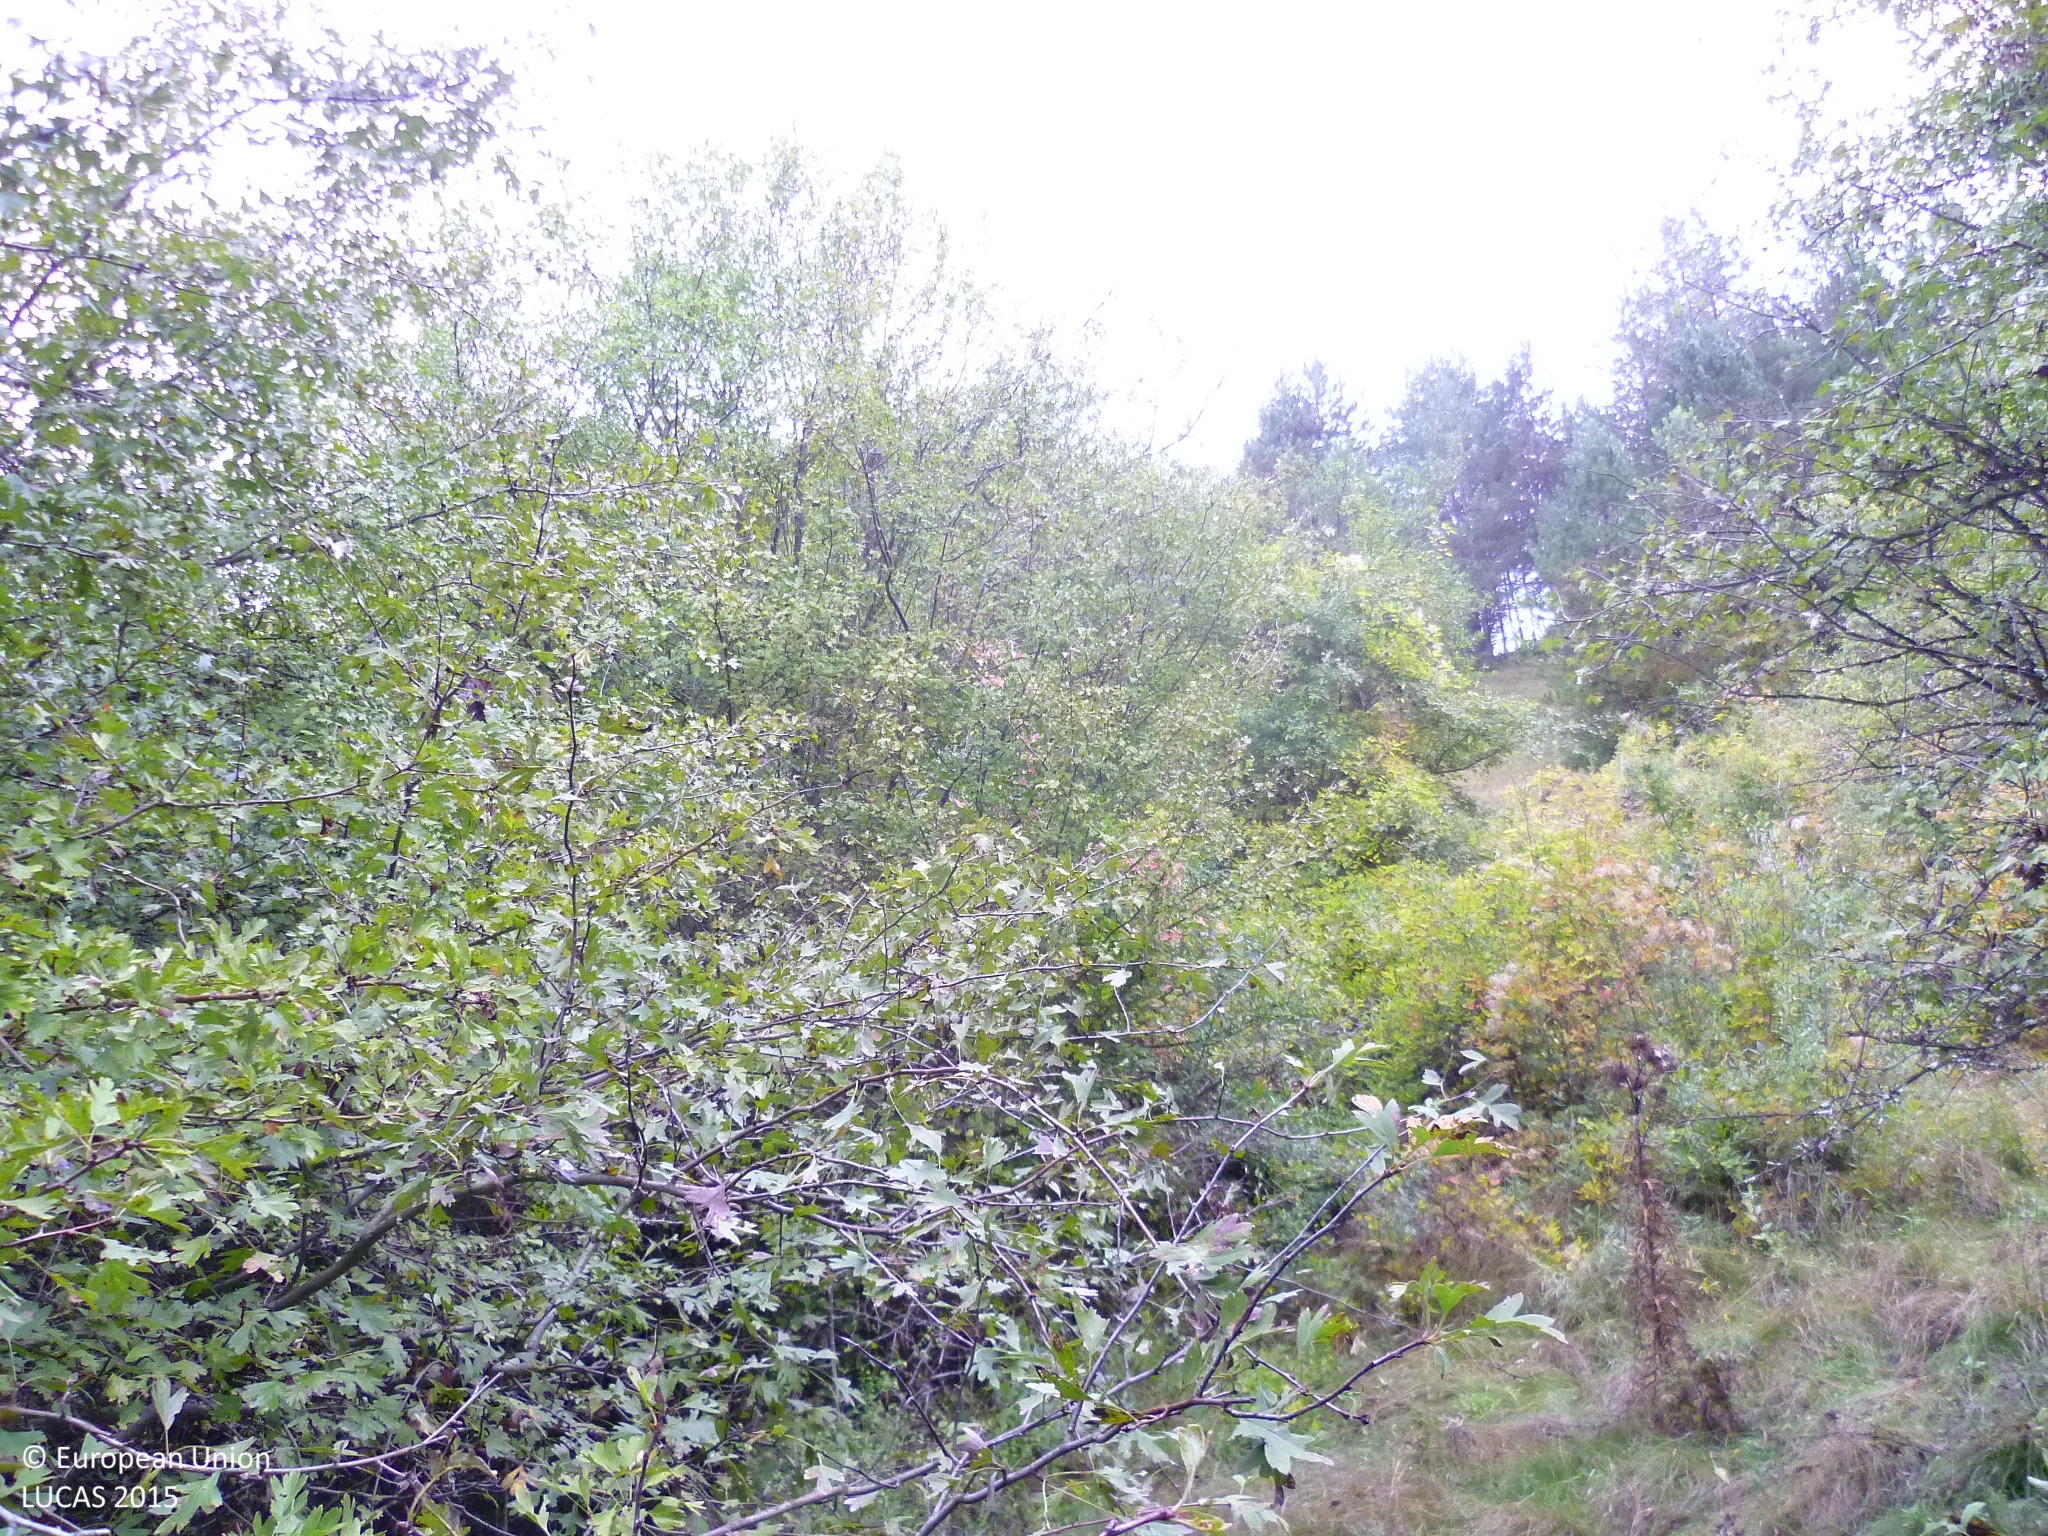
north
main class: Shrubland
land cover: Shrubland with sparse tree cover
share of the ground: > 75 %
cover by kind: shrubs 90 %, broadleaved forest trees 5 %, herbaceous plants 5 %
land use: Semi-natural and natural areas not in use
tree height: < 5 m
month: September
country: BG
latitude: 42.7488
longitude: 22.8191
